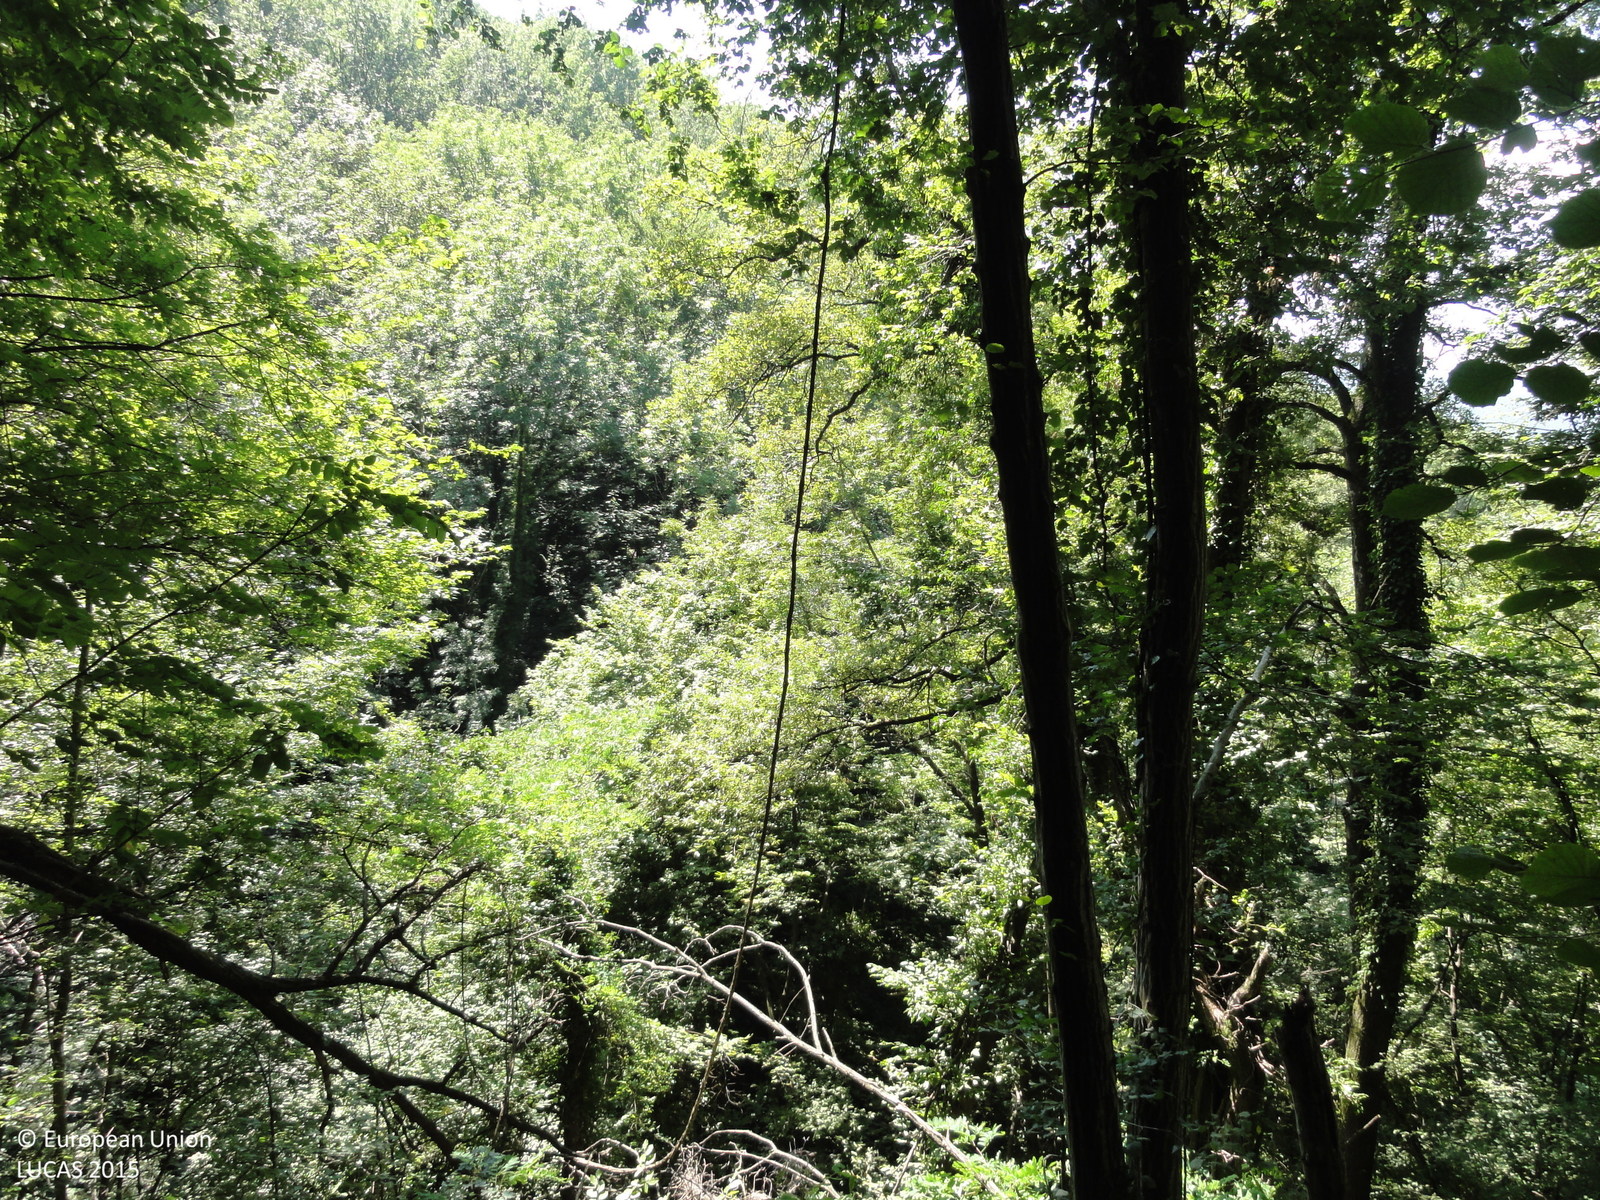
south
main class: Woodland
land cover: Broadleaved woodland
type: mesophytic deciduous forest
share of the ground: > 75 %
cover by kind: broadleaved forest trees 100 %
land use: Semi-natural and natural areas not in use
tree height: > 5 m
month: August
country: SI
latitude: 46.1101
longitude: 13.6061
